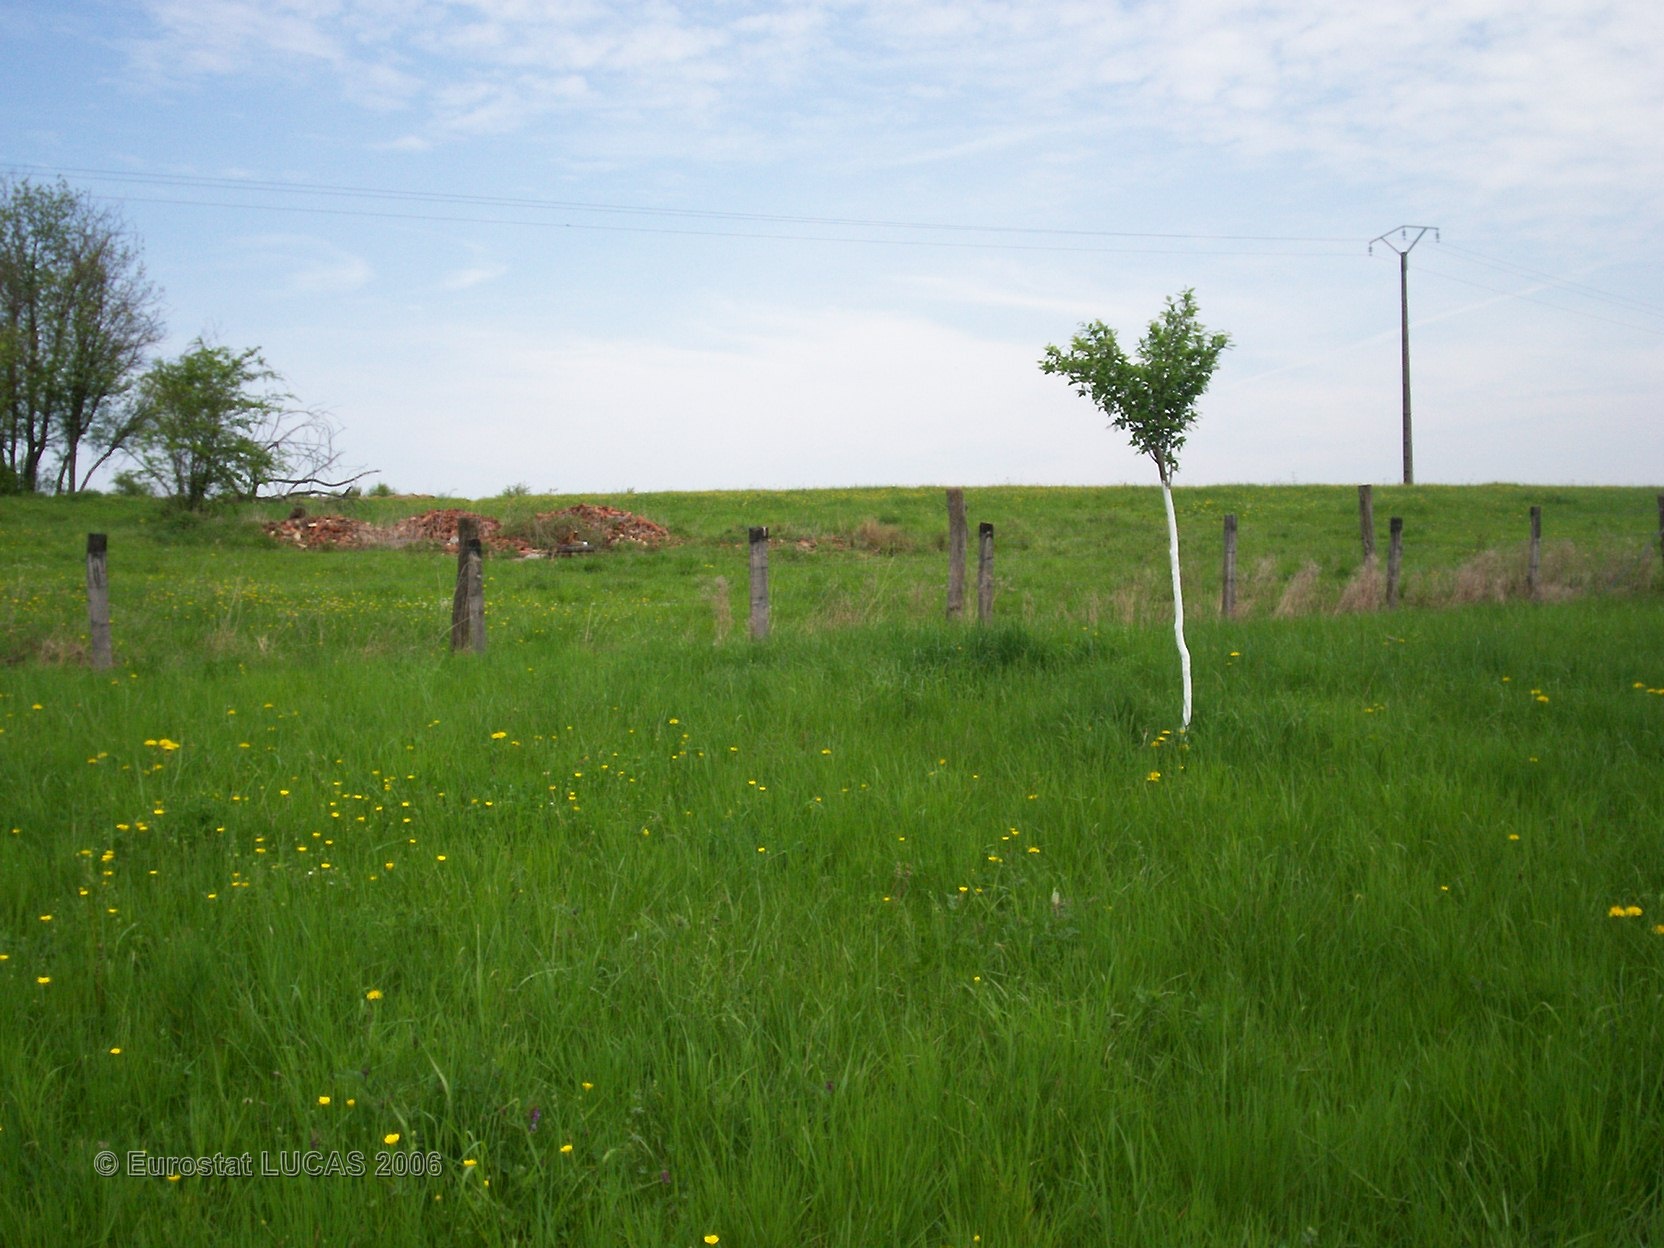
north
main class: Cropland
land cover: Other fruit trees and berries
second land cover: Grassland with sparse tree/shrub cover
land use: Agriculture (excluding fallow land and kitchen gardens)
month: May
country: FR
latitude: 48.4926
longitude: 5.9810
